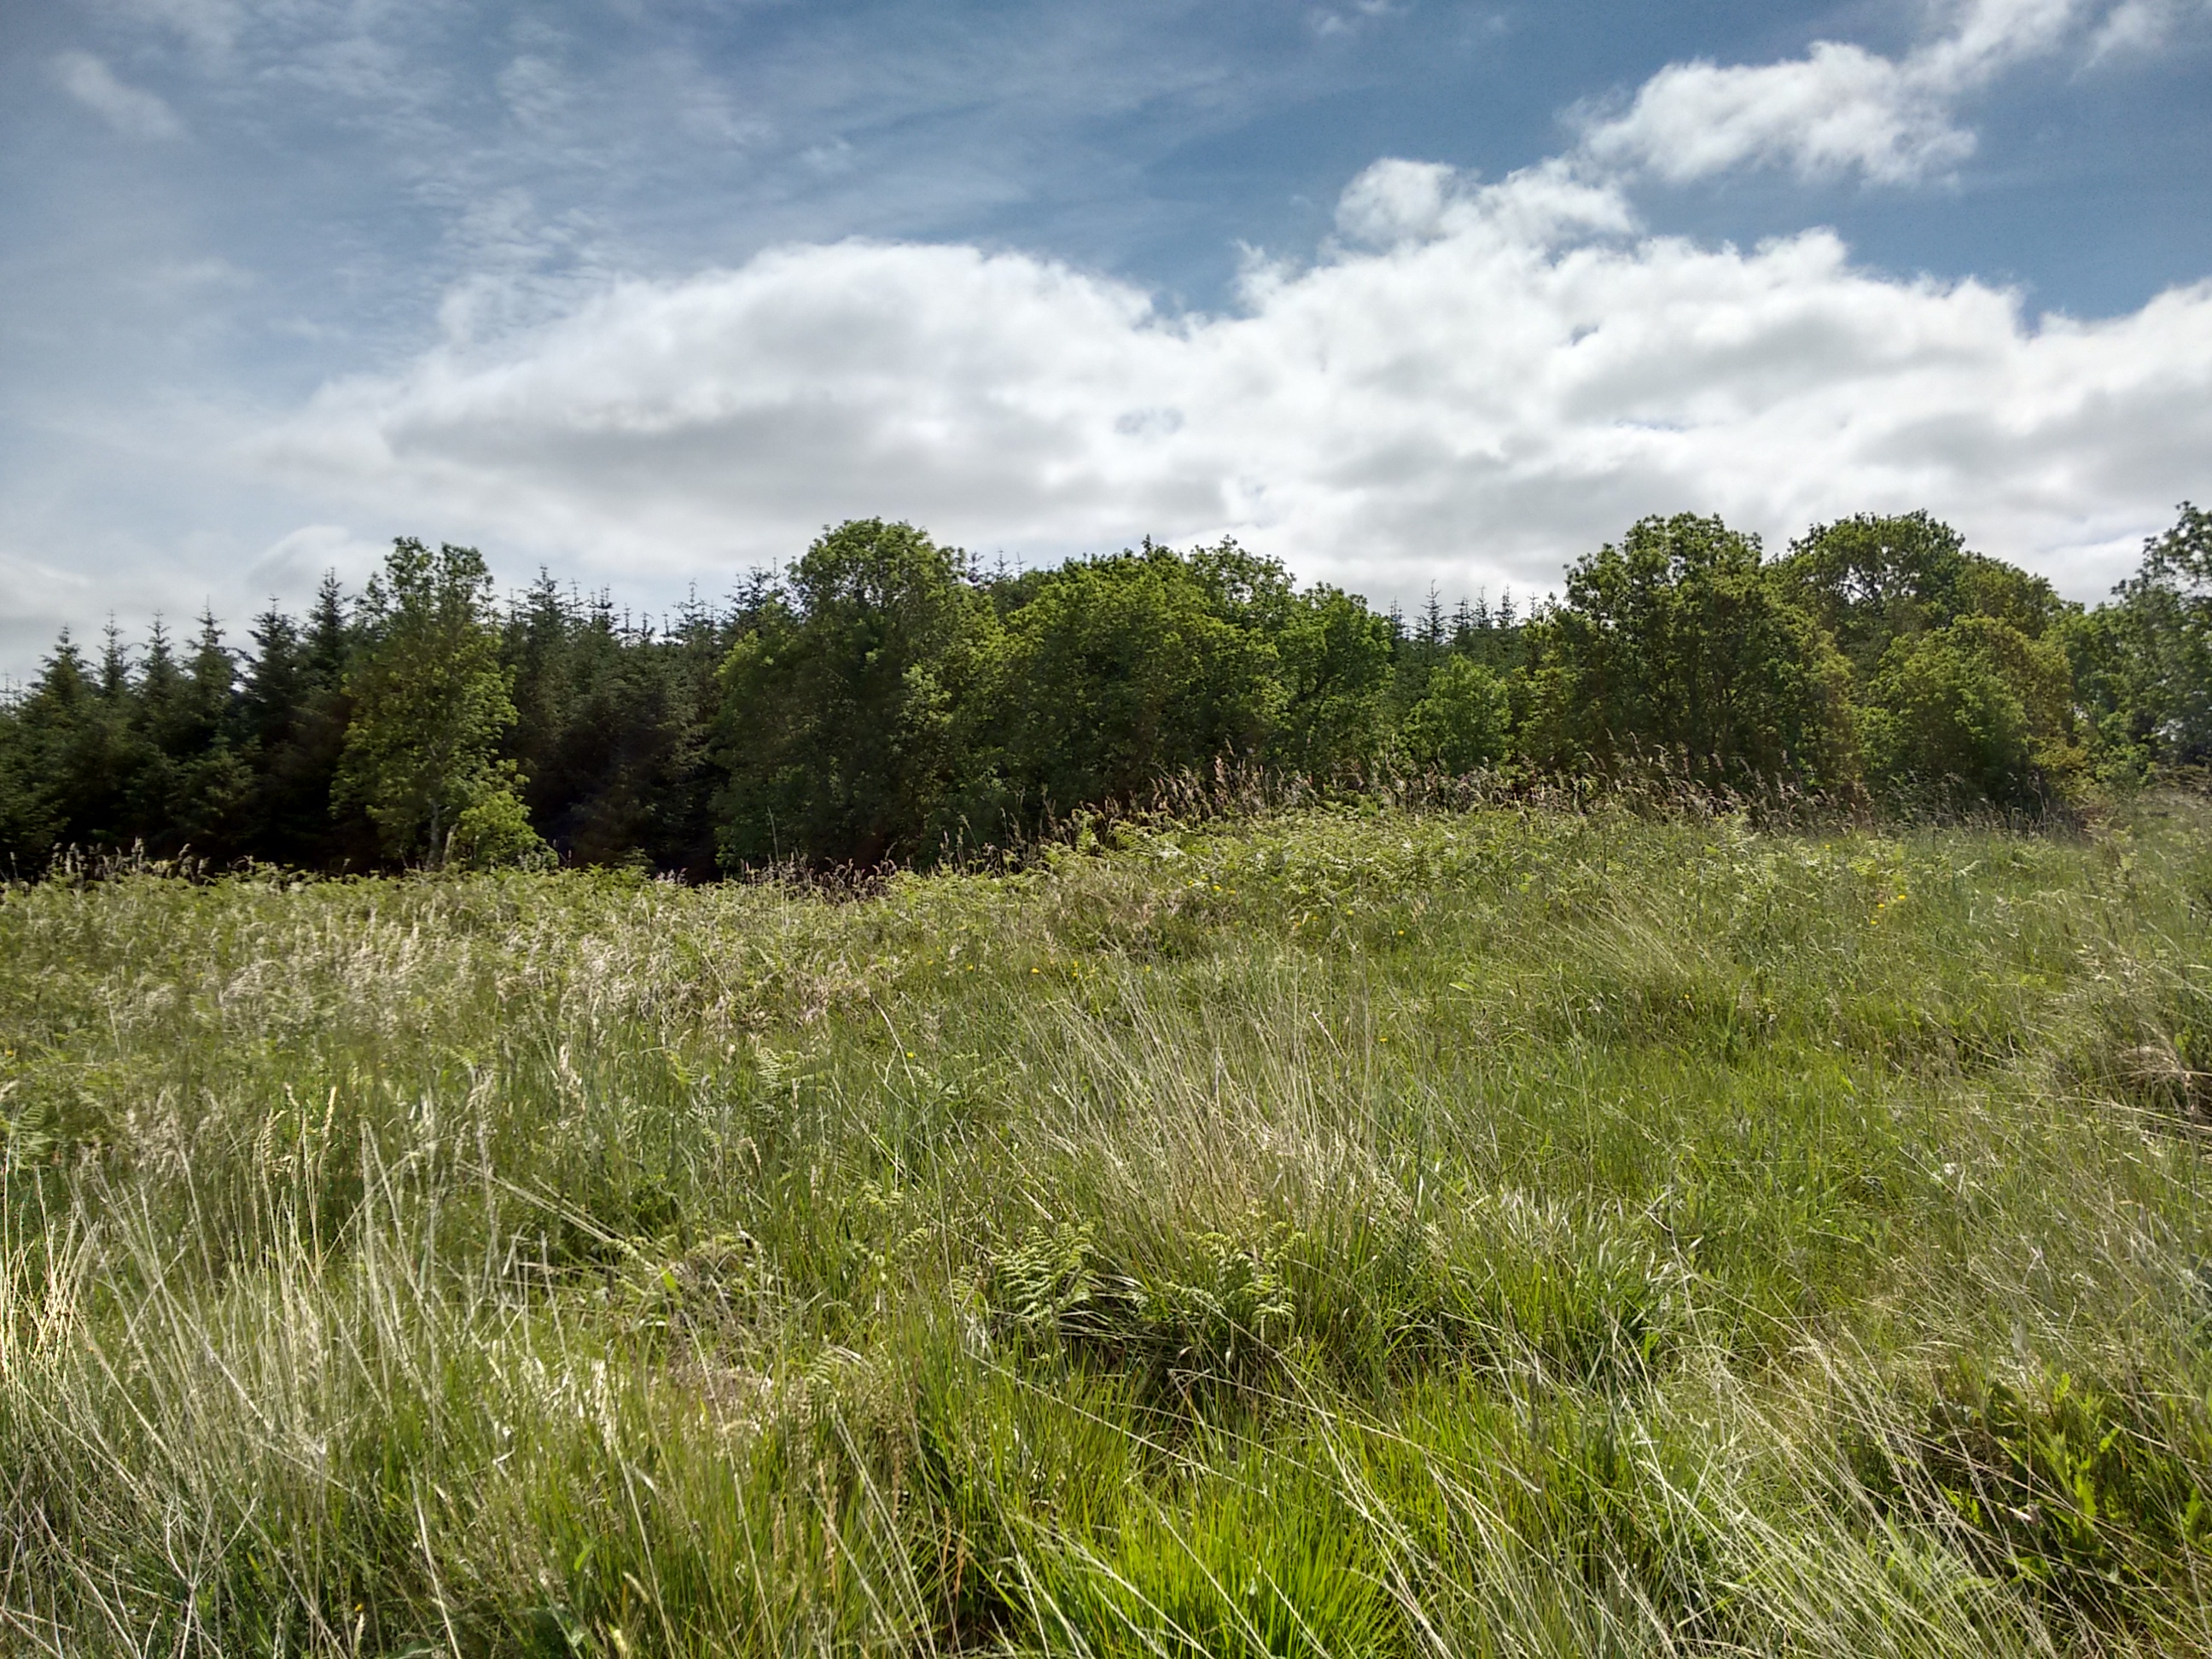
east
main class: Grassland
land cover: Grassland without tree/shrub cover
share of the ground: > 75 %
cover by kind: herbaceous plants 100 %
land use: Agriculture (excluding fallow land and kitchen gardens)
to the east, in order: Grassland without tree/shrub cover; Broadleaved woodland; Dry stone walls; Fences; Broadleaved woodland; Fences; Broadleaved woodland; Grassland without tree/shrub cover; Spruce dominated coniferous woodland
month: June
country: IE
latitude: 53.2258
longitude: -8.5444
